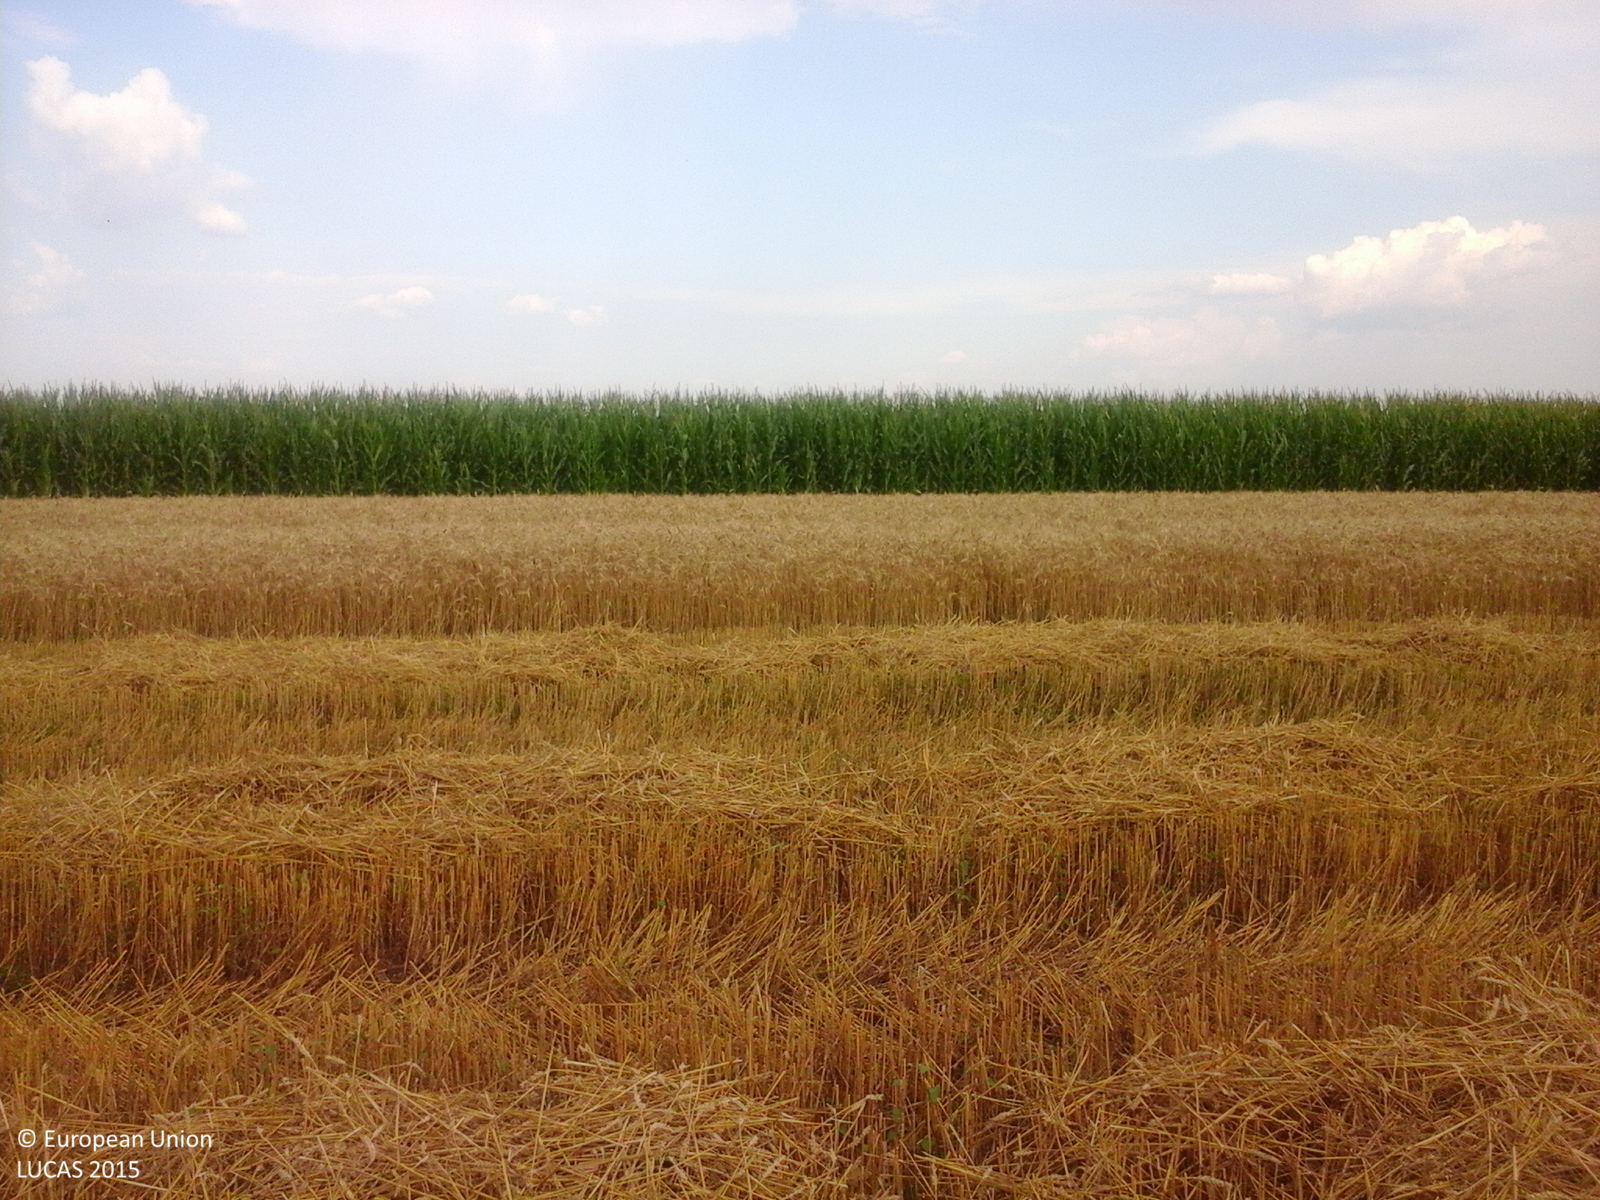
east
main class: Cropland
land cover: Common wheat
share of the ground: > 75 %
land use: Agriculture (excluding fallow land and kitchen gardens)
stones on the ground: < 10 %
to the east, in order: Common wheat; Maize; Sunflower; Maize; Common wheat; Maize; Sunflower; Maize
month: July
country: RO
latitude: 43.9317
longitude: 25.7241
